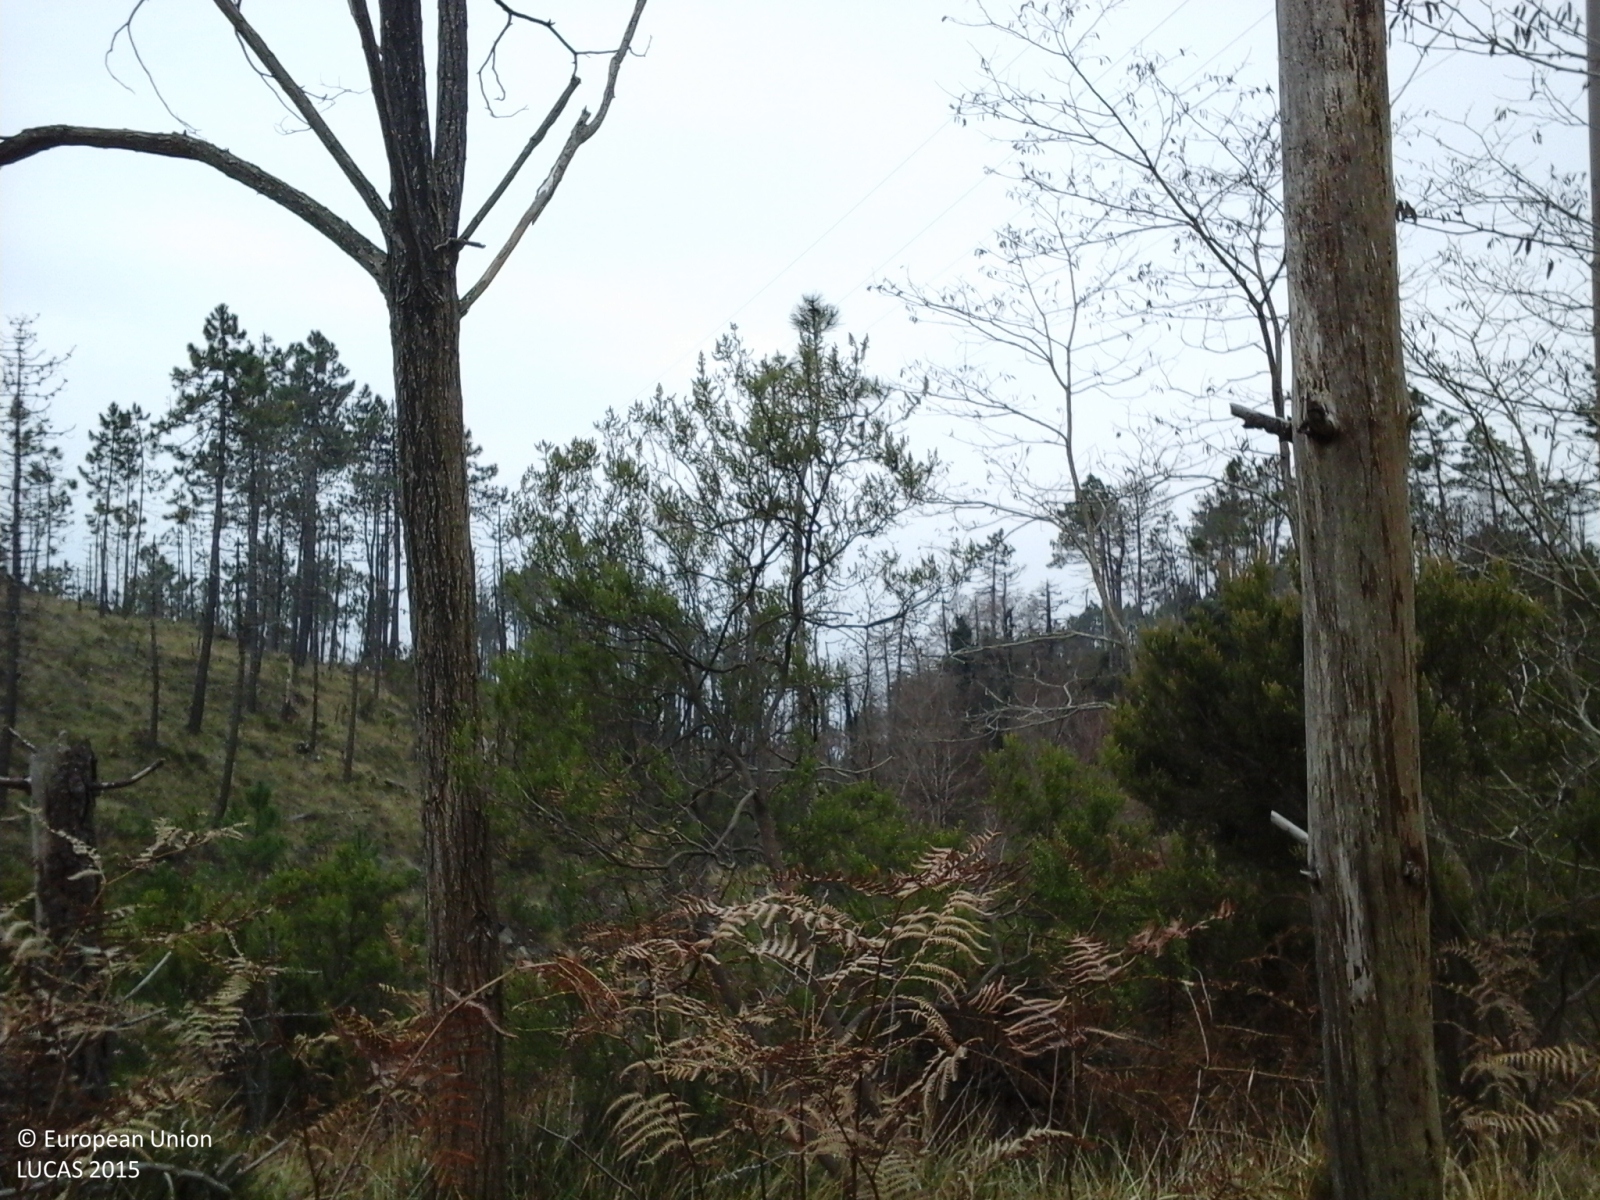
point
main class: Woodland
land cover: Pine dominated coniferous woodland
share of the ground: > 75 %
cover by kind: coniferous forest trees 75 %, broadleaved forest trees 15 %, shrubs 5 %, herbaceous plants 5 %
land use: Forestry
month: October
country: IT
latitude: 44.2054
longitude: 9.5880
